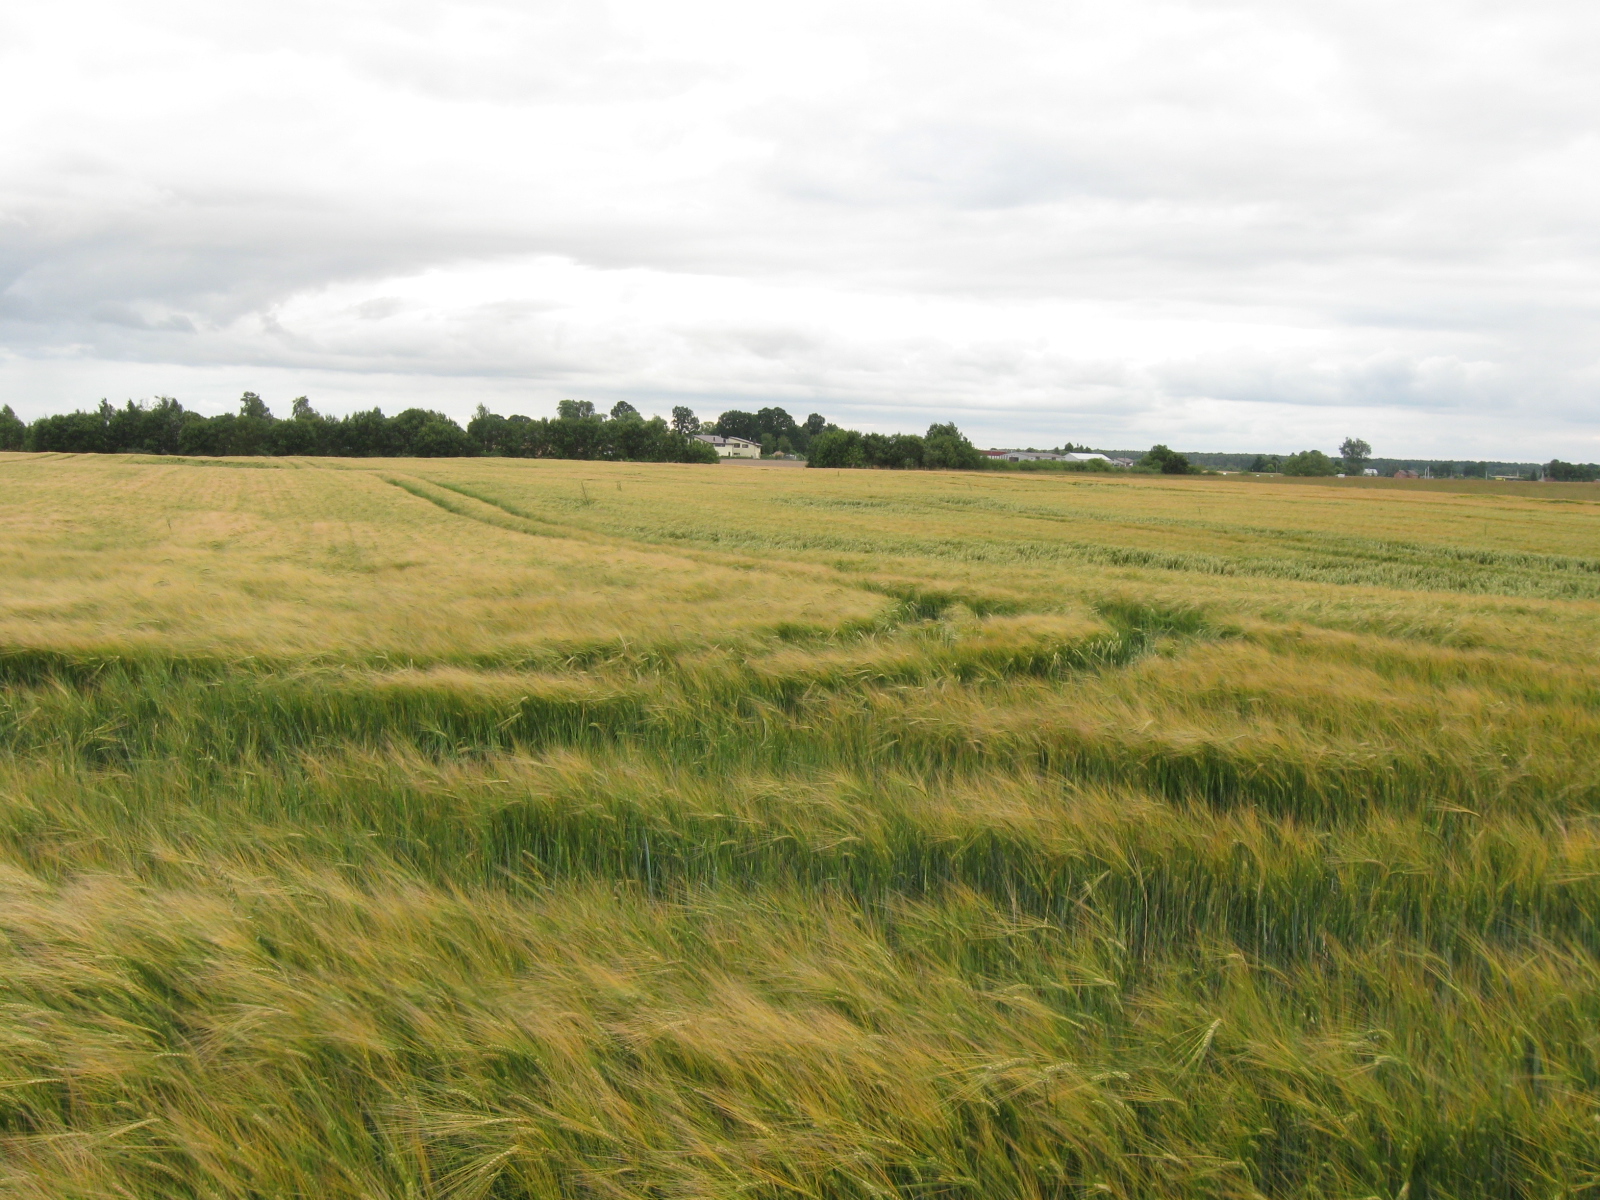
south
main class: Cropland
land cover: Barley
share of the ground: > 75 %
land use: Agriculture (excluding fallow land and kitchen gardens)
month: July
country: LT
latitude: 54.9112
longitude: 23.7661
